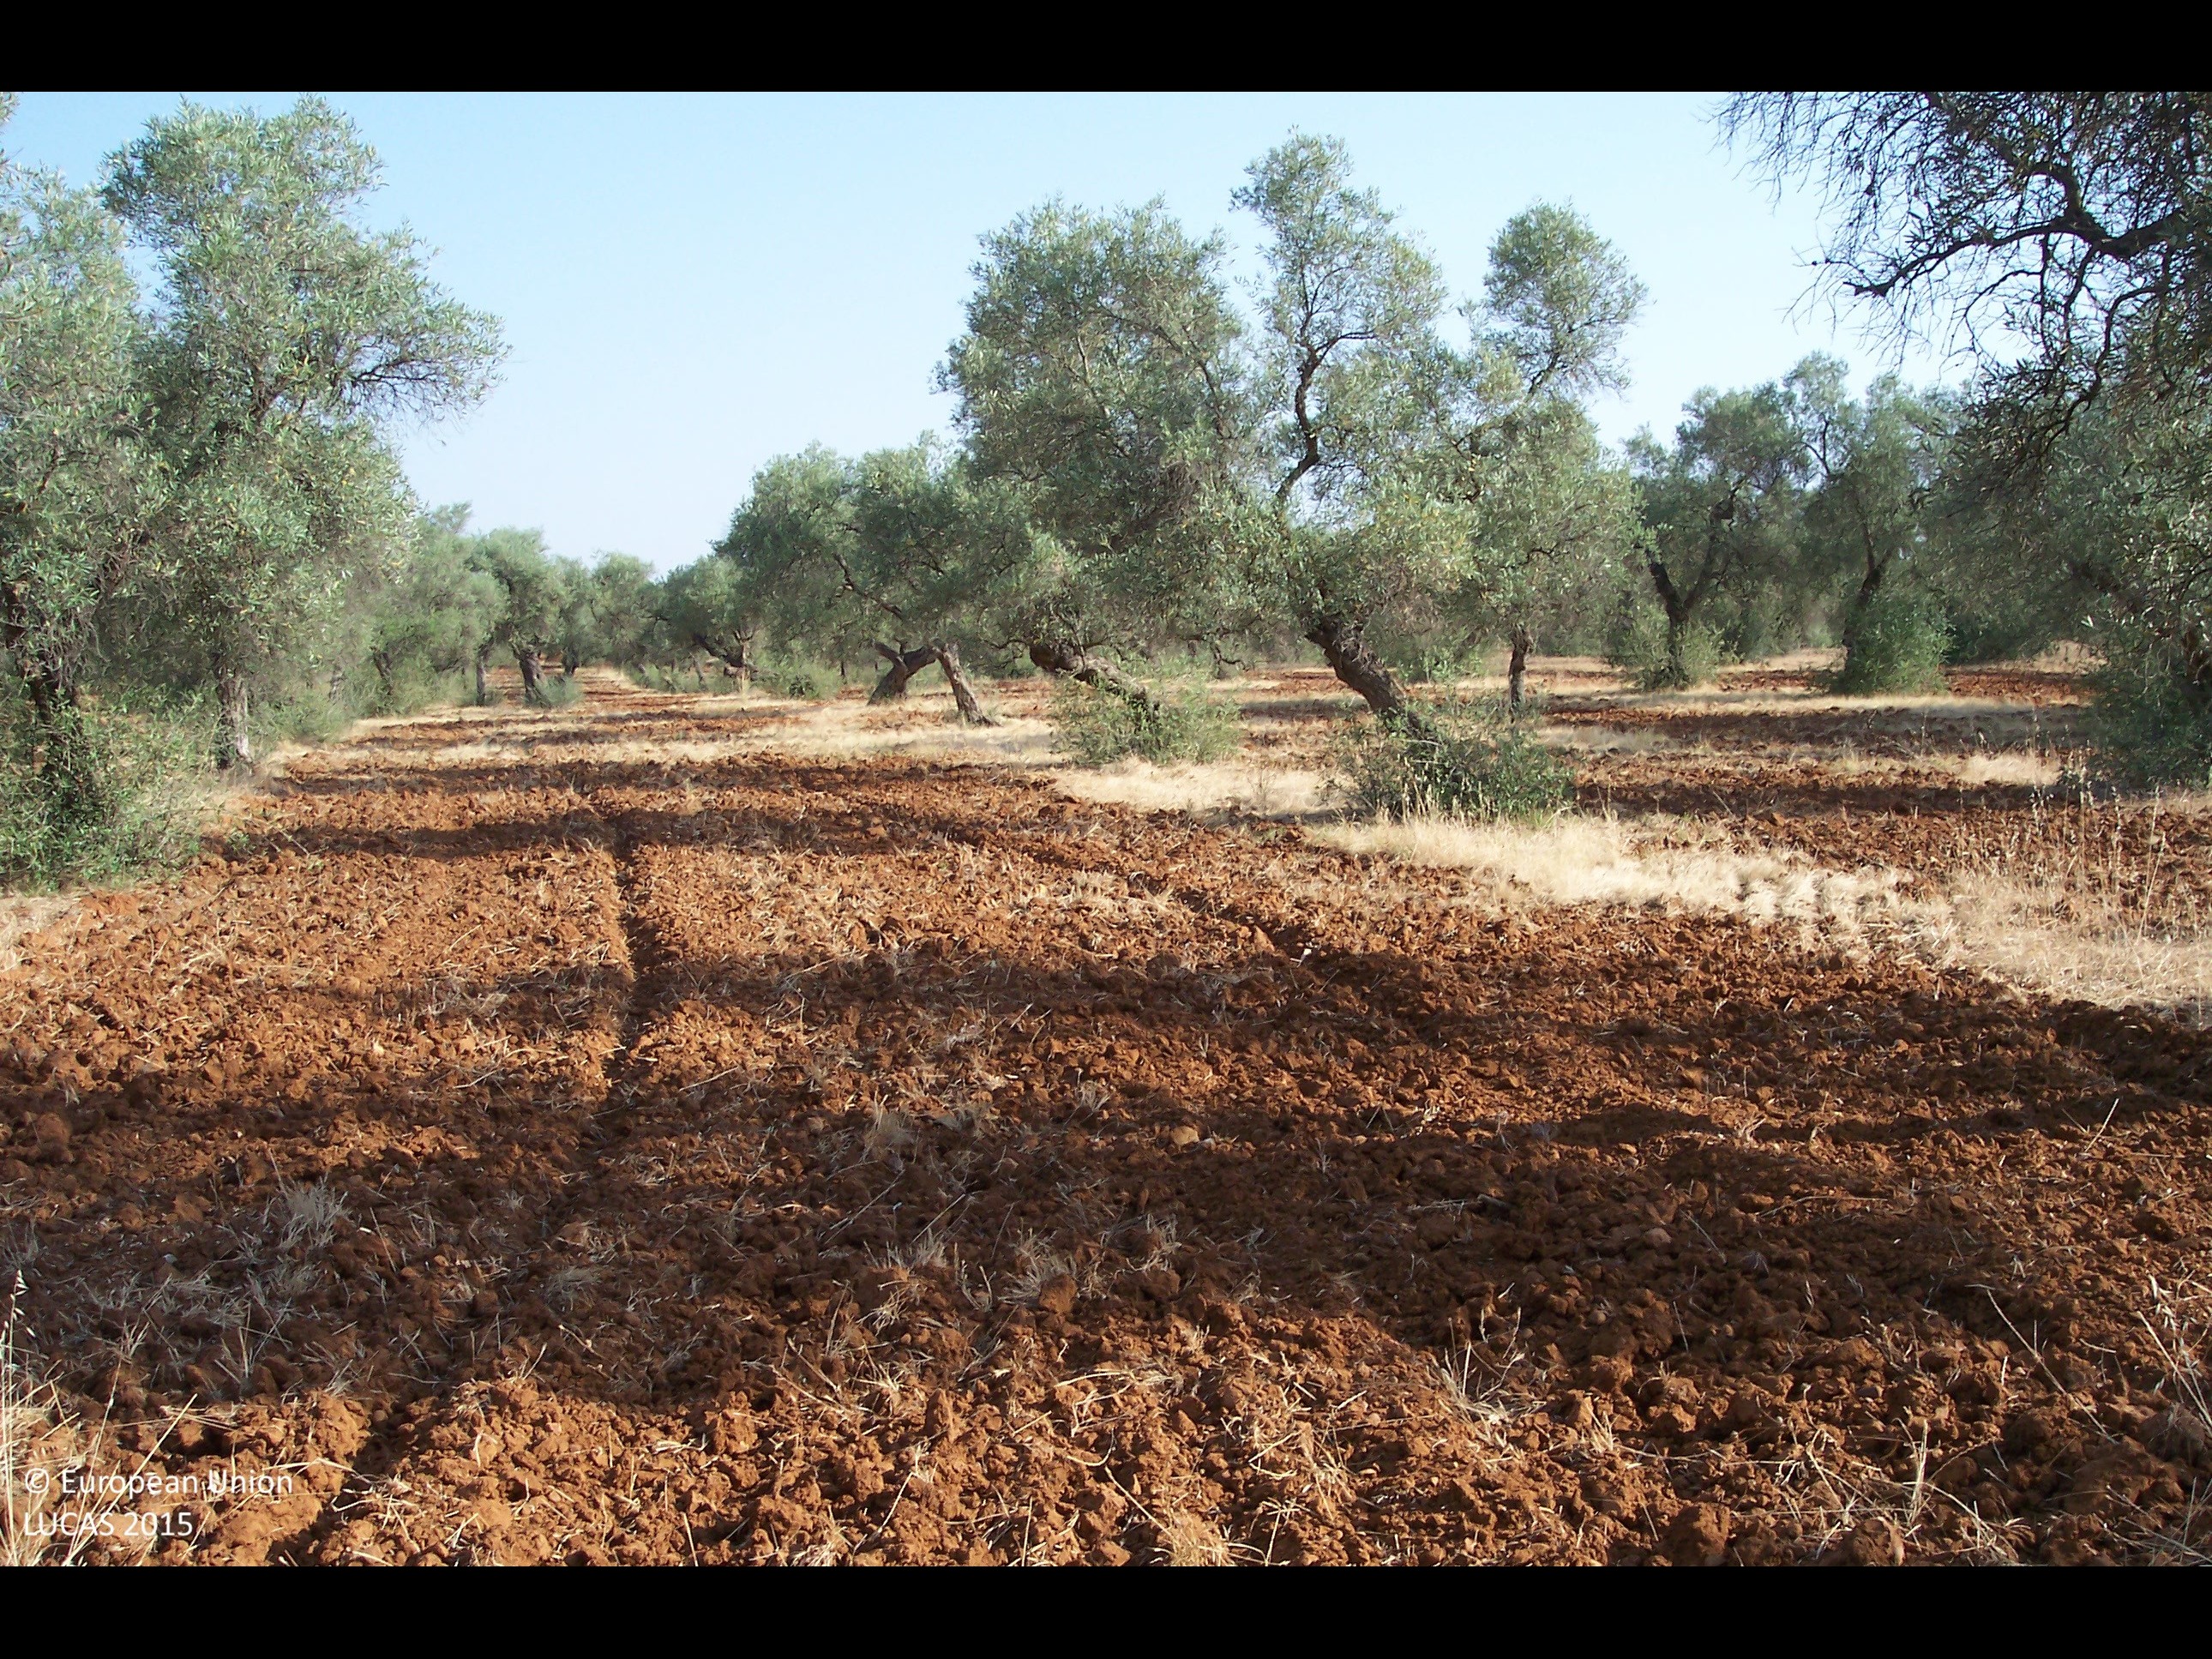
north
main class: Cropland
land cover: Olive groves
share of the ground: 10 - 25 %
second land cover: Other bare soil
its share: > 75 %
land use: Agriculture (excluding fallow land and kitchen gardens)
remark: Harvested field
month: June
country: ES
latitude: 37.3225
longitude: -5.8987
